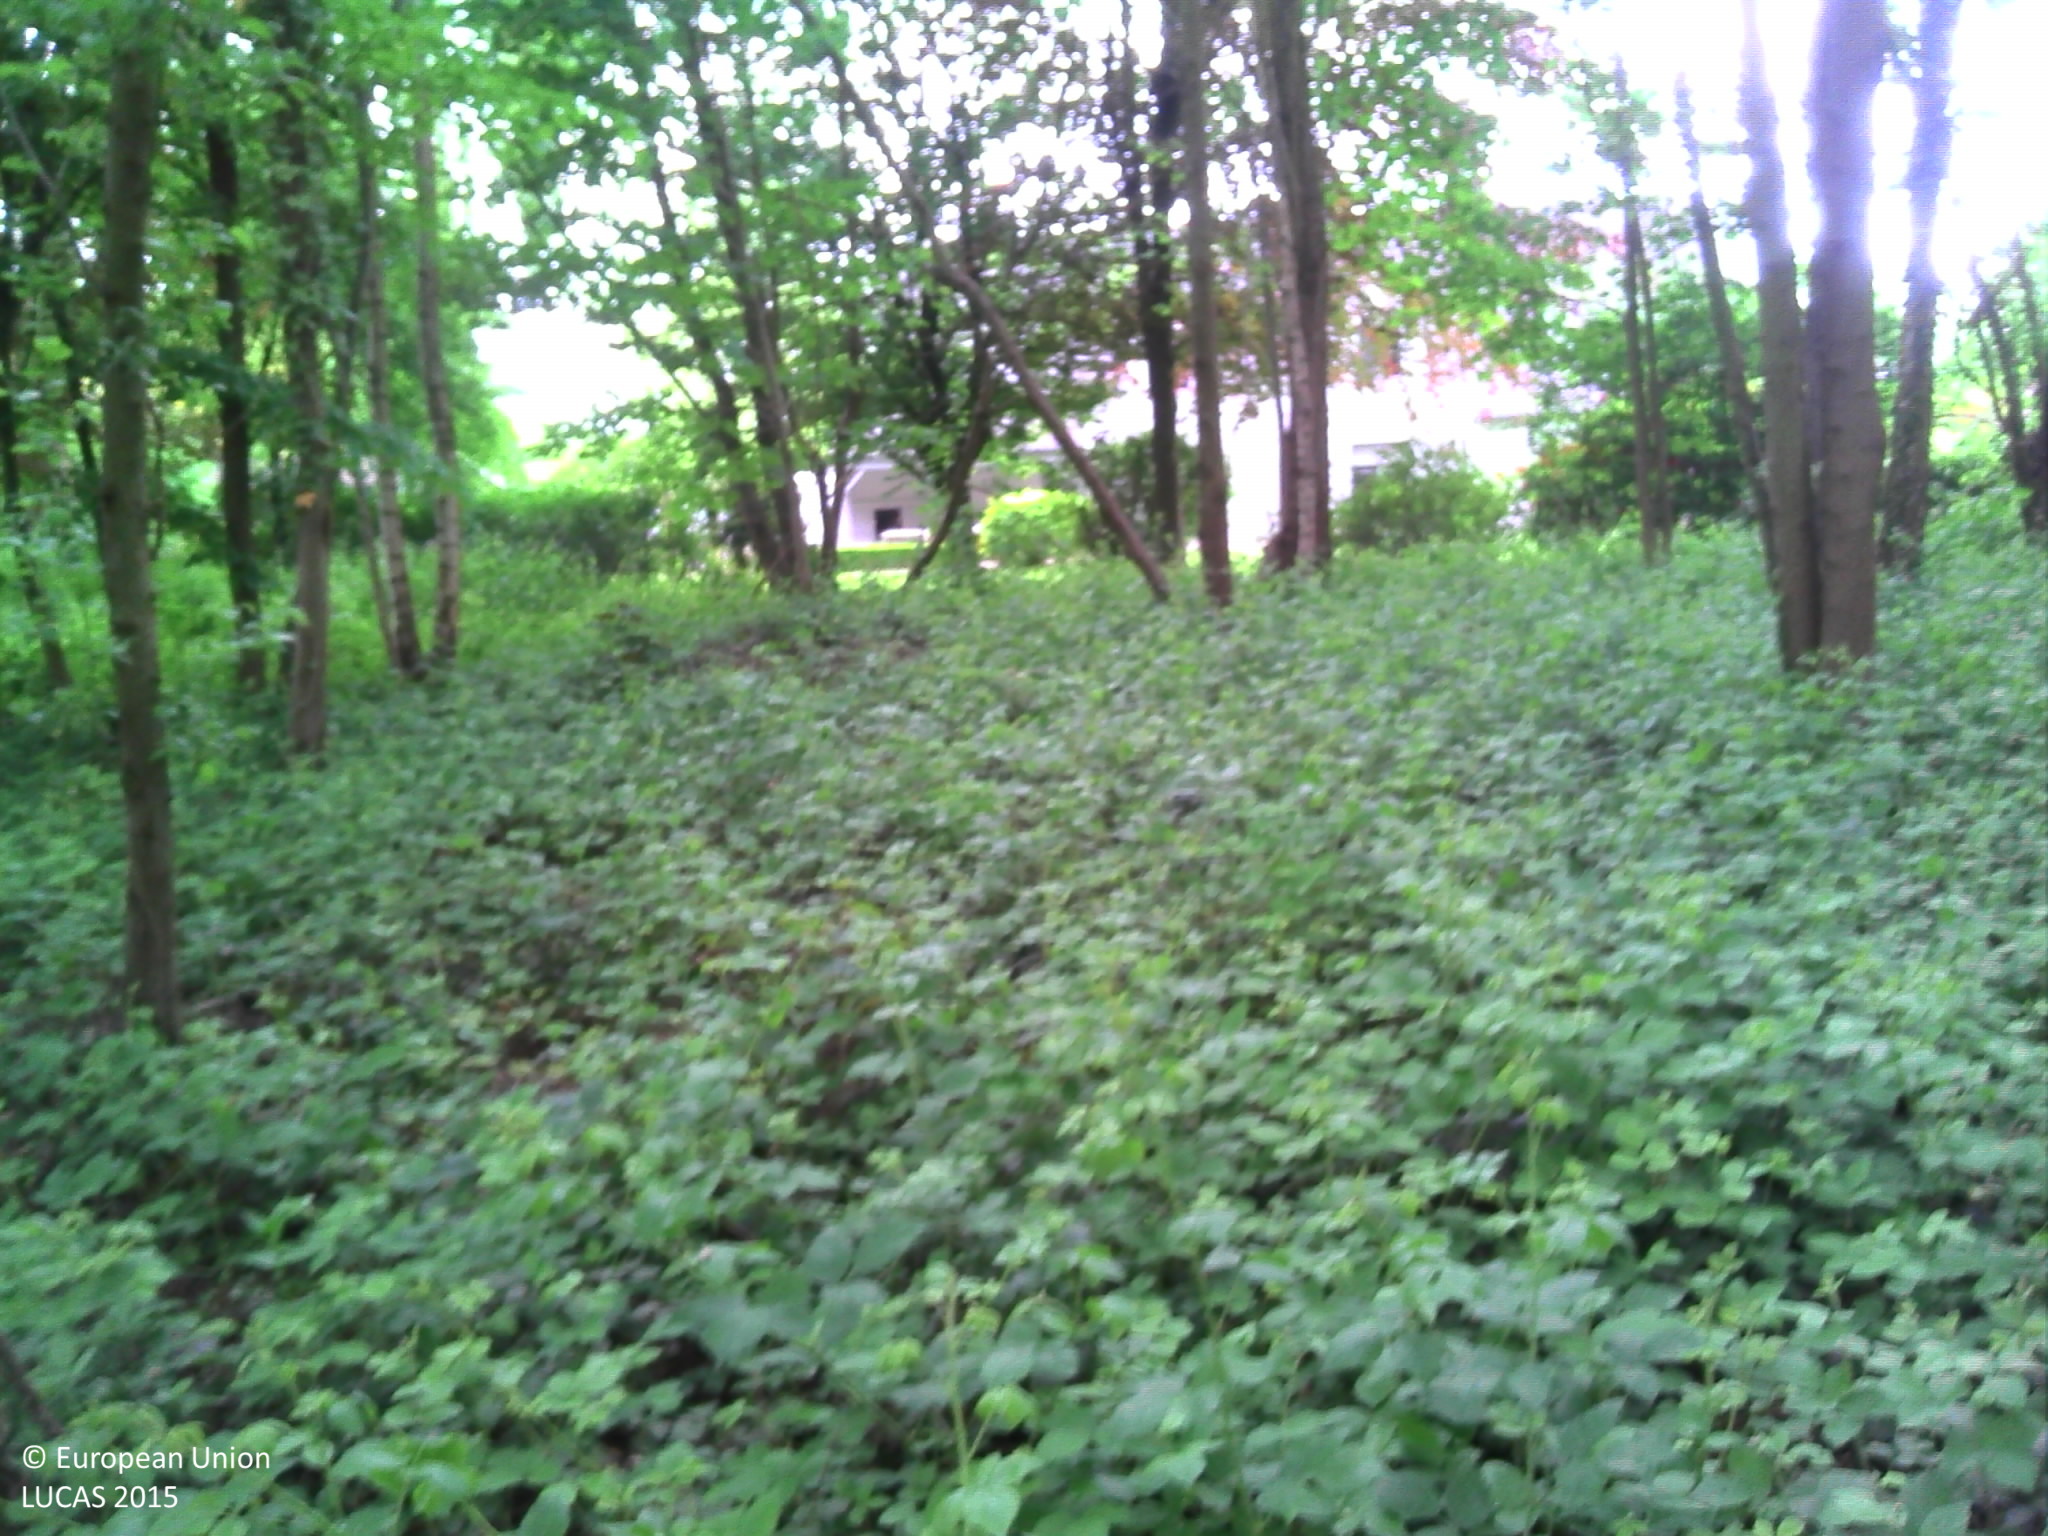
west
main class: Woodland
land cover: Broadleaved woodland
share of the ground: > 75 %
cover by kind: broadleaved forest trees 100 %
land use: Forestry
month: May
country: BE
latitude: 50.6984
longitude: 4.4599
